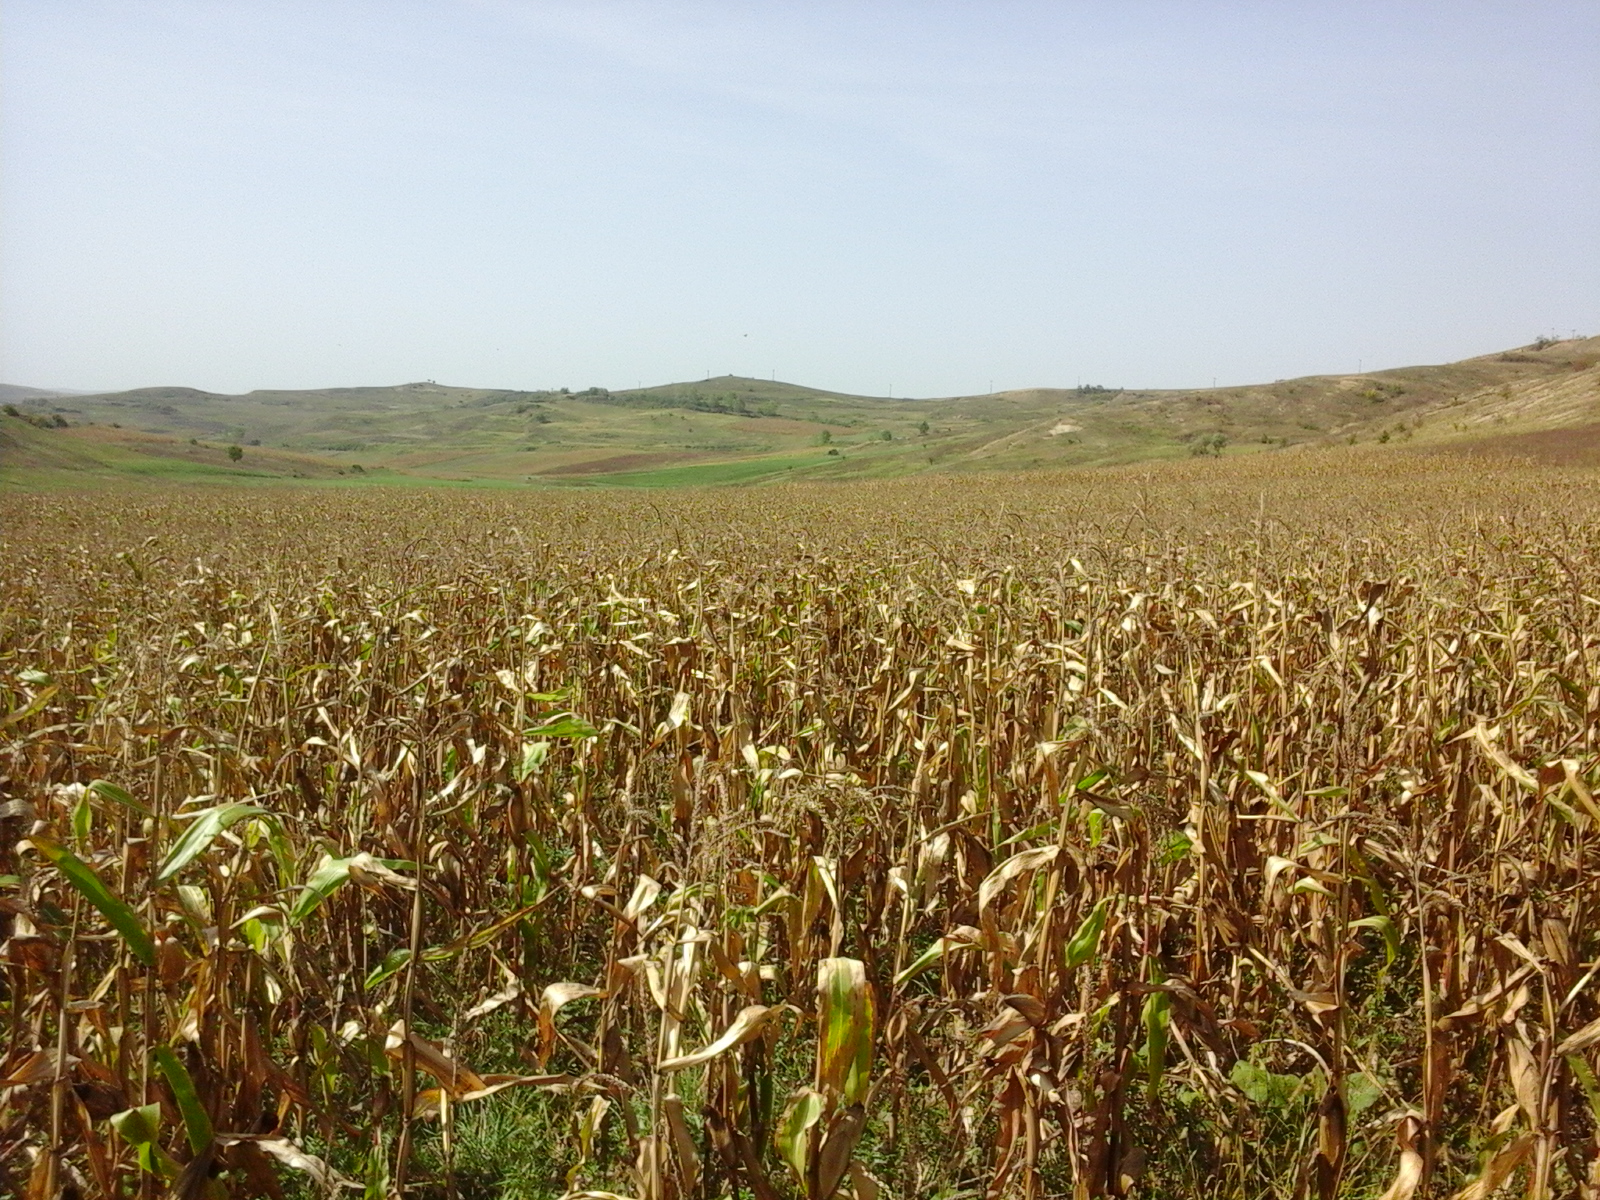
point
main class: Cropland
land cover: Maize
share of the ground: > 75 %
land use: Agriculture (excluding fallow land and kitchen gardens)
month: September
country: RO
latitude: 46.8641
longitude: 23.8904
